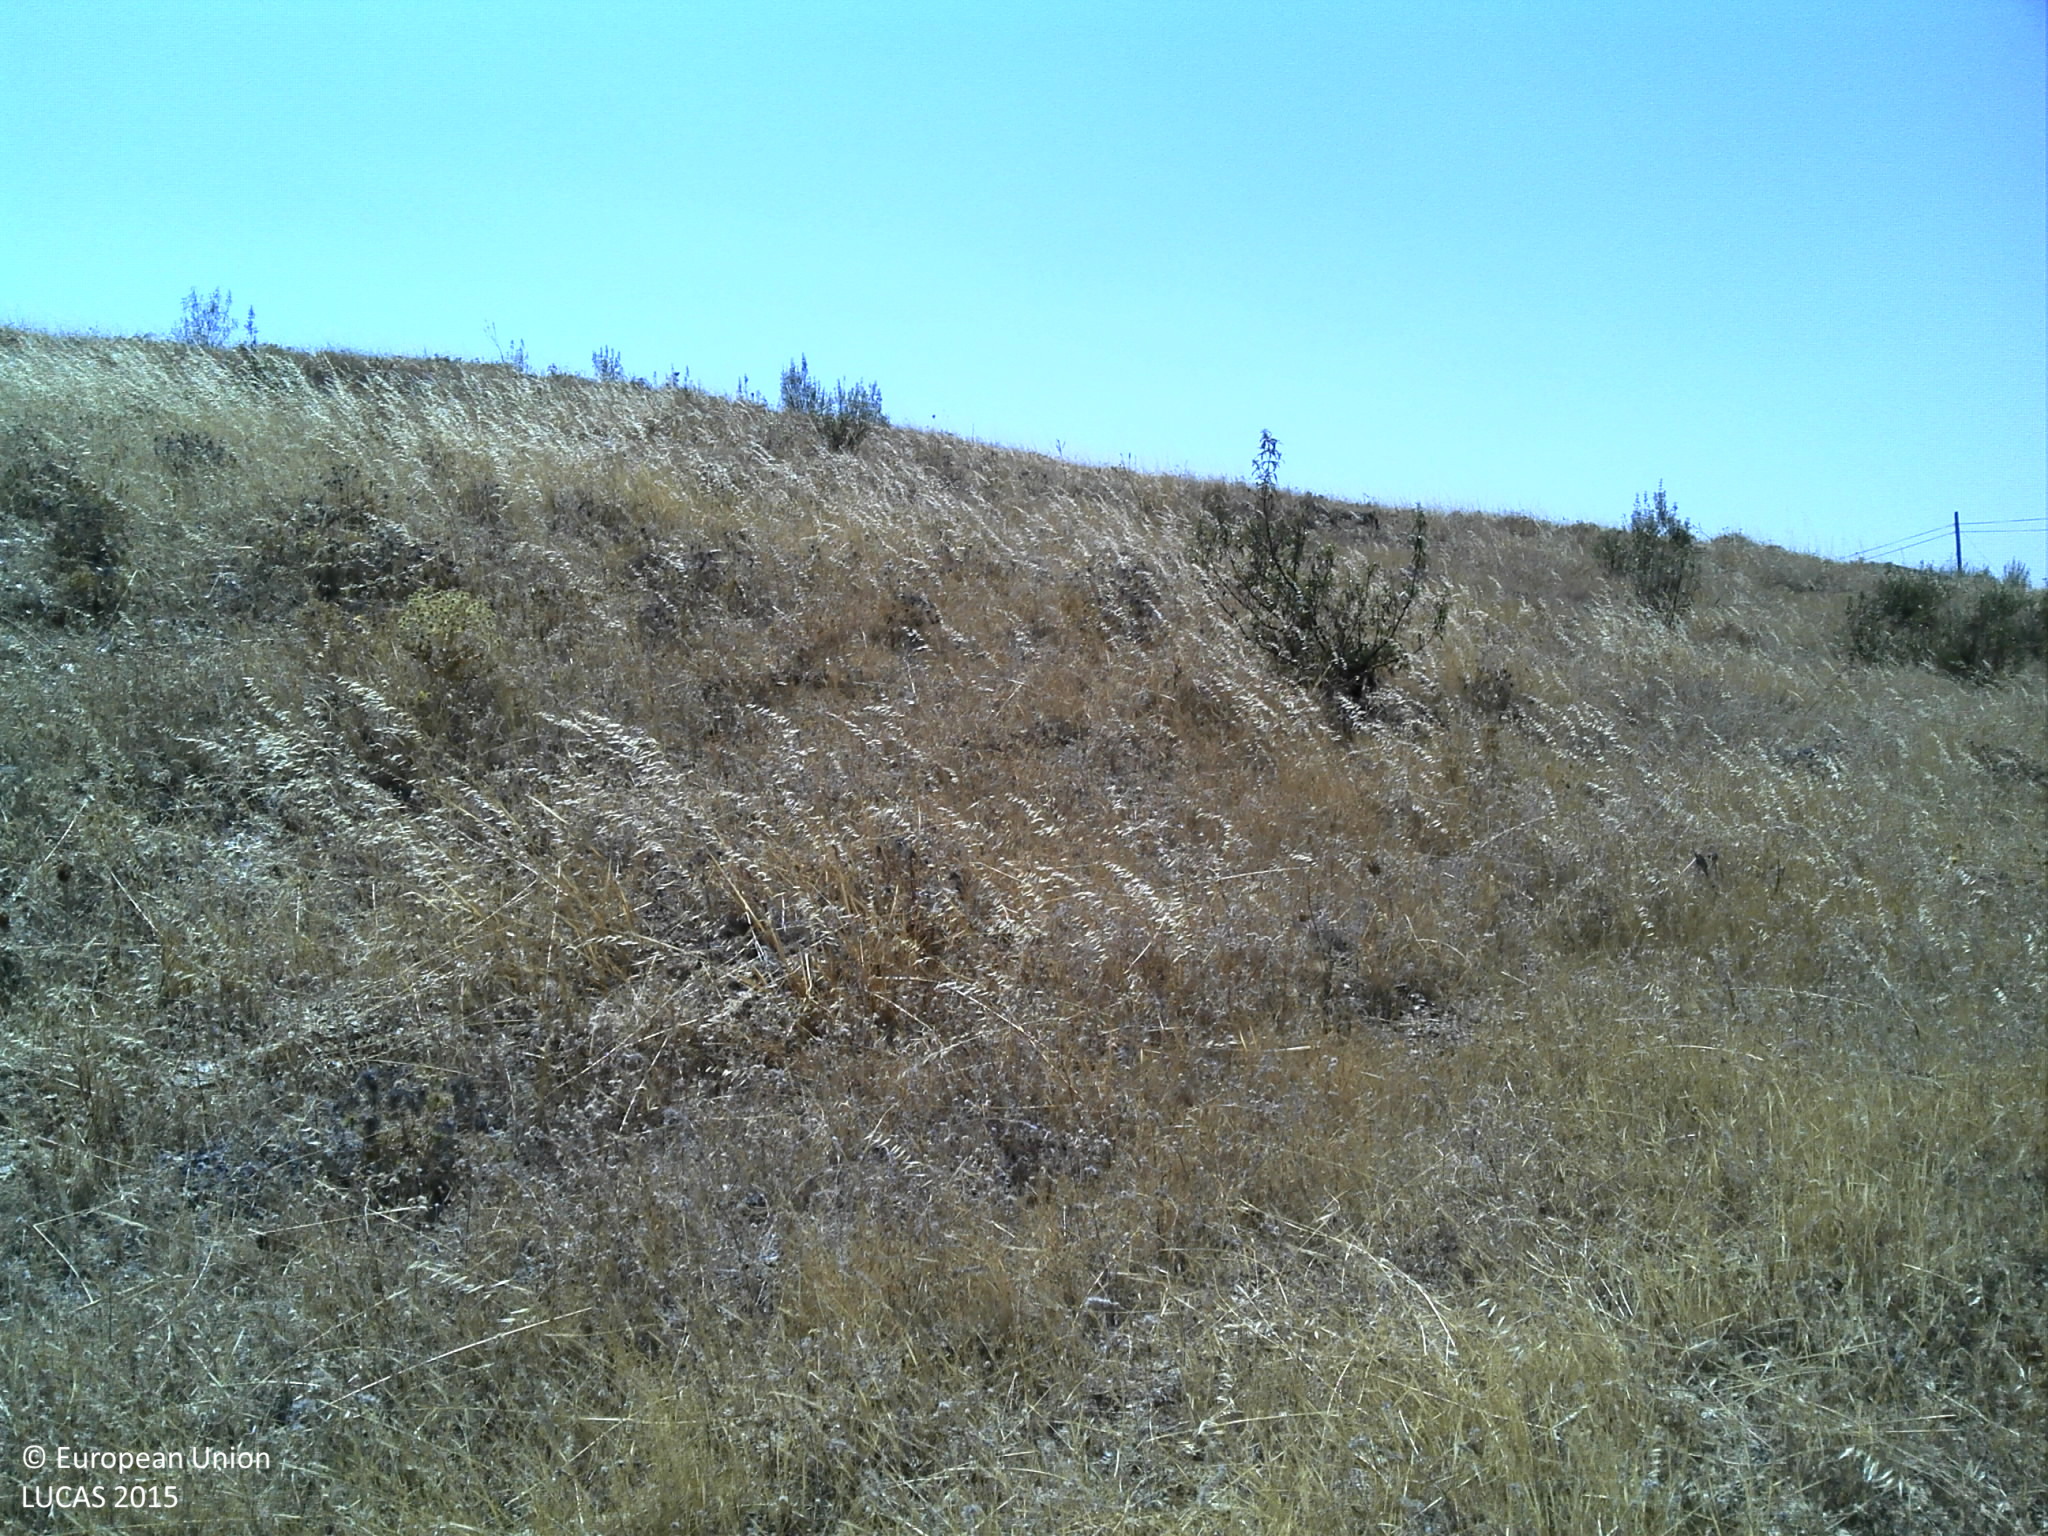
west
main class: Grassland
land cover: Grassland without tree/shrub cover
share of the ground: > 75 %
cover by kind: herbaceous plants 90 %, unconsolidated bare surface 10 %
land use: Agriculture (excluding fallow land and kitchen gardens)
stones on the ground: < 10 %
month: July
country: PT
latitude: 37.5567
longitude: -7.7777
